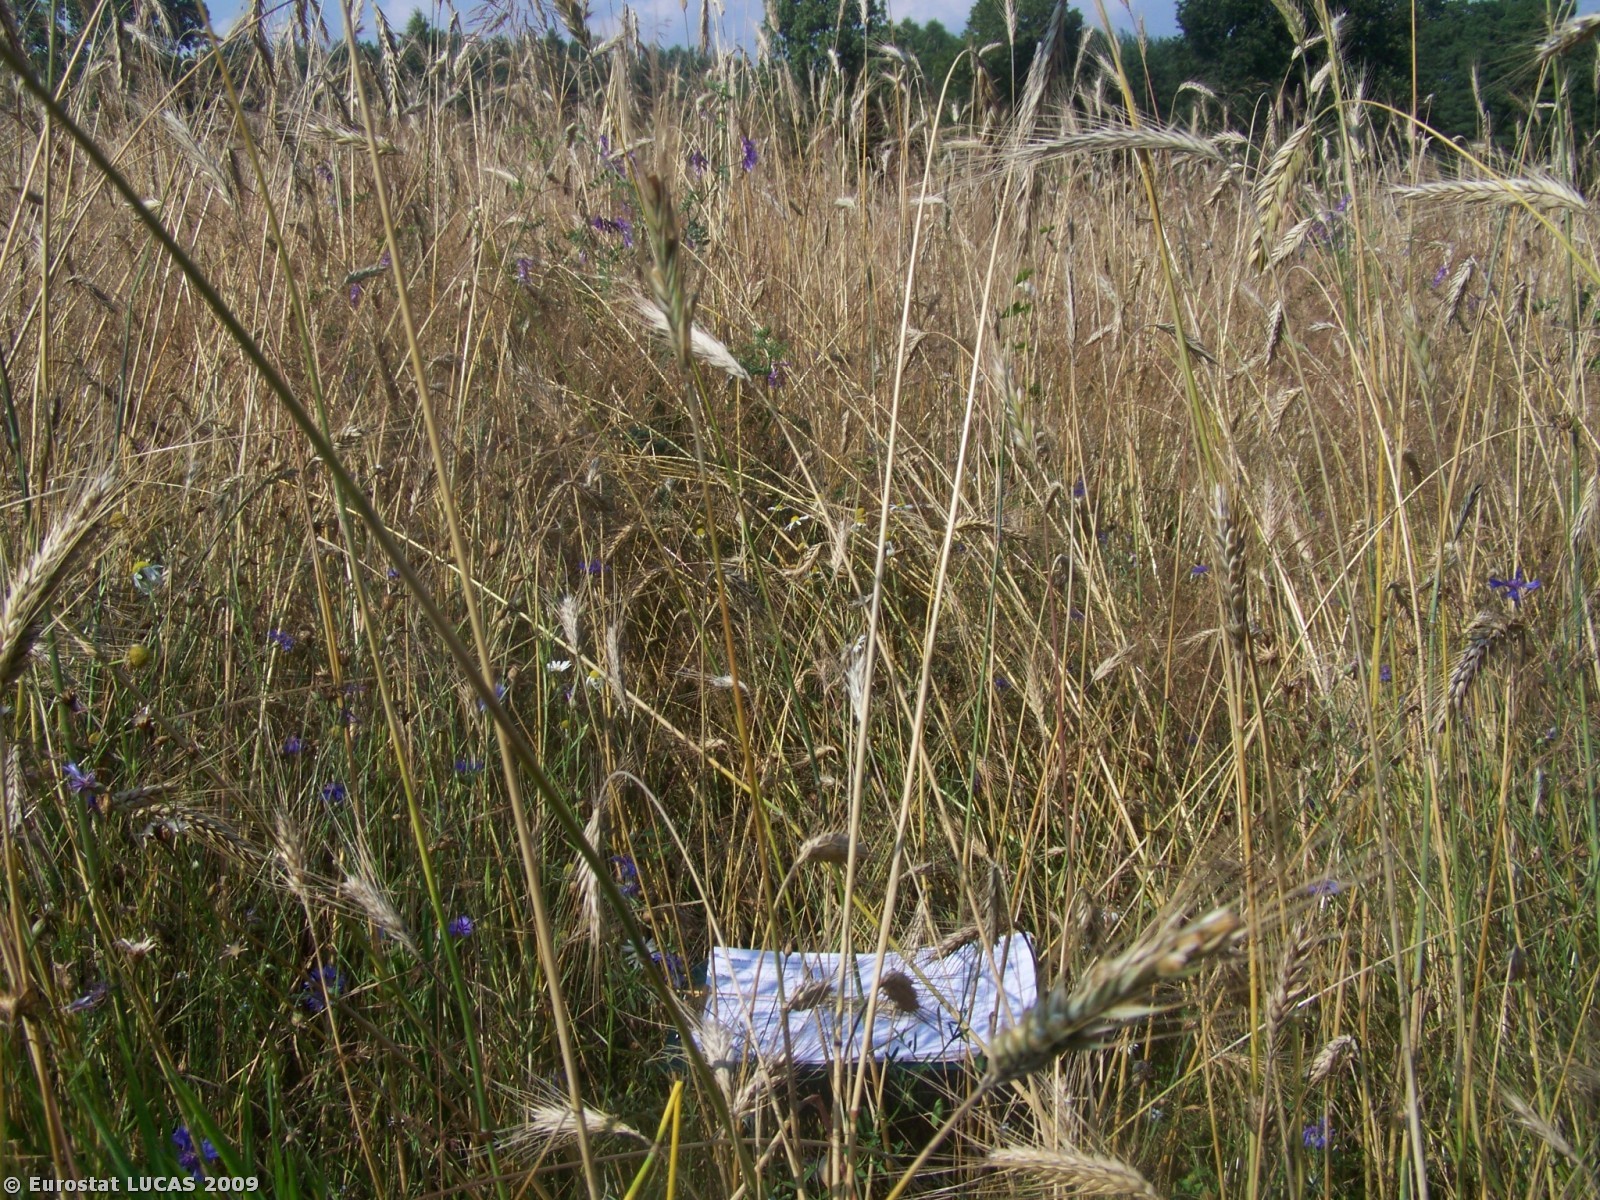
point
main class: Cropland
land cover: Rye
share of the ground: > 75 %
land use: Agriculture (excluding fallow land and kitchen gardens)
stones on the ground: < 10 %
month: July
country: PL
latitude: 52.0887
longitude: 21.6858
